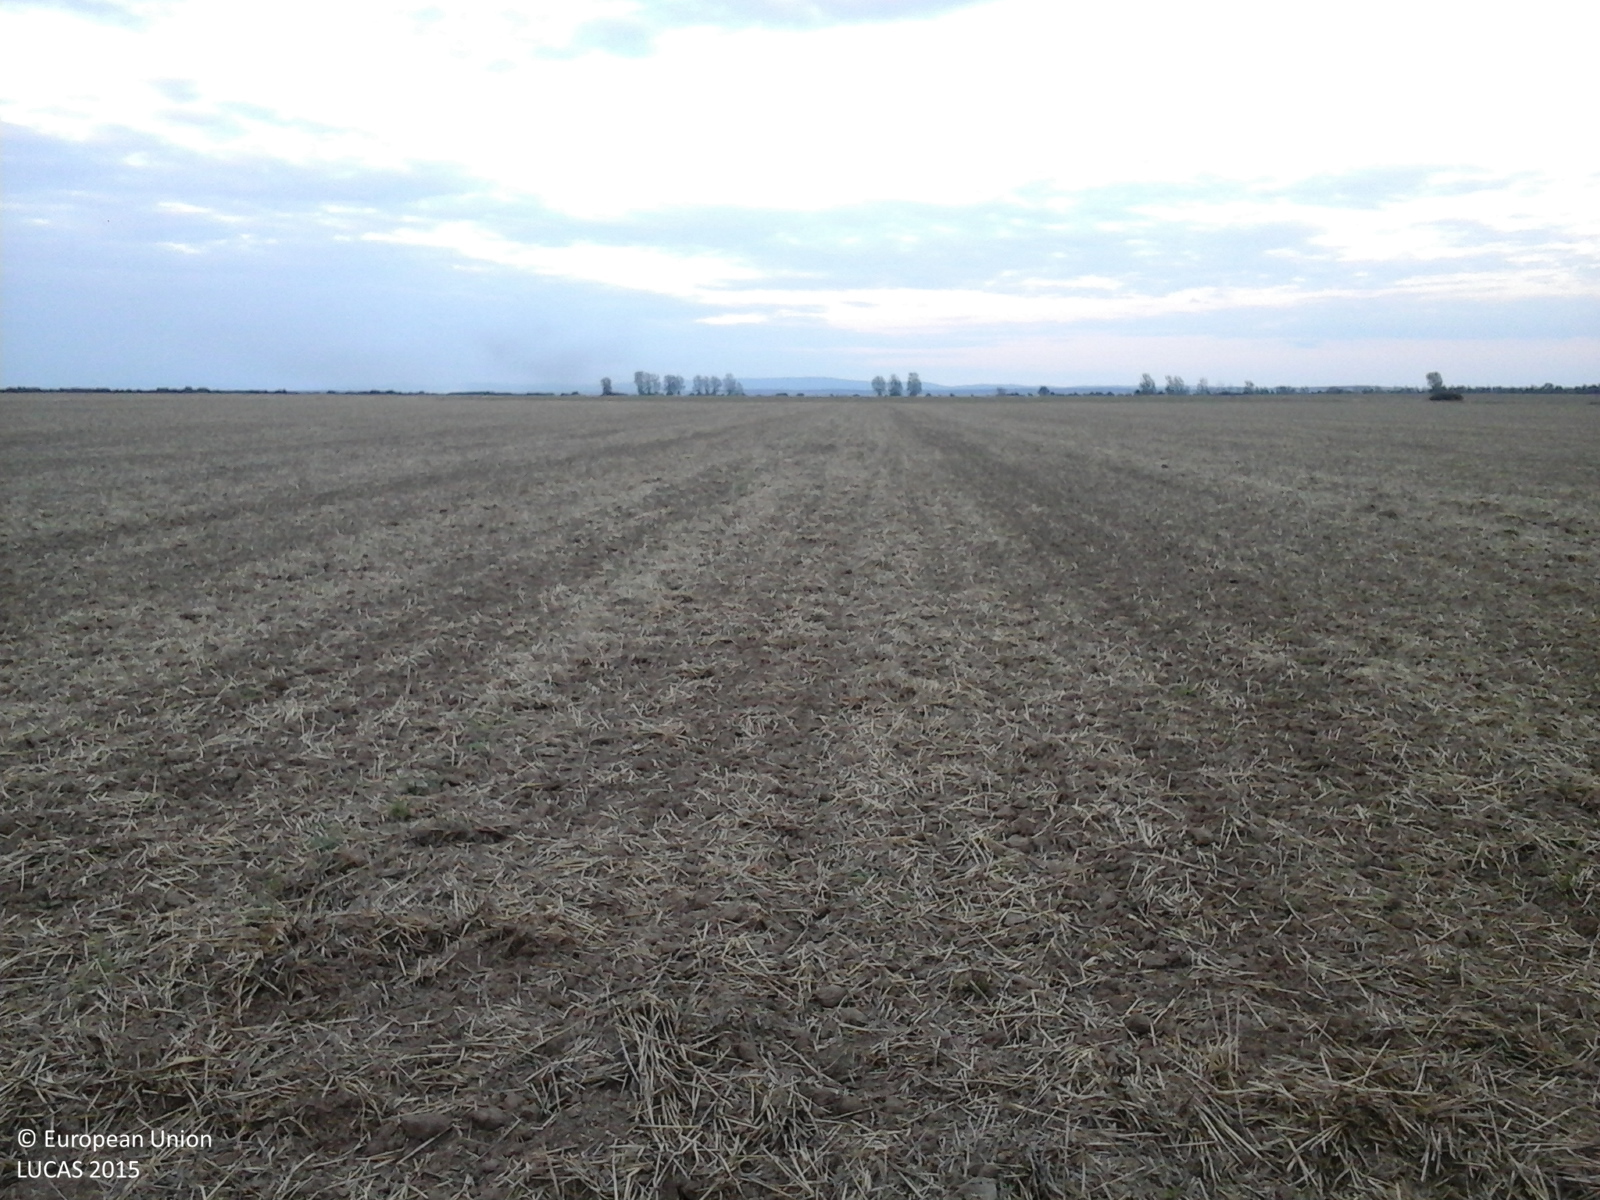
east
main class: Cropland
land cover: Common wheat
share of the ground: < 10 %
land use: Agriculture (excluding fallow land and kitchen gardens)
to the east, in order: Common wheat
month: September
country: RO
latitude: 47.5200
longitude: 22.7166
